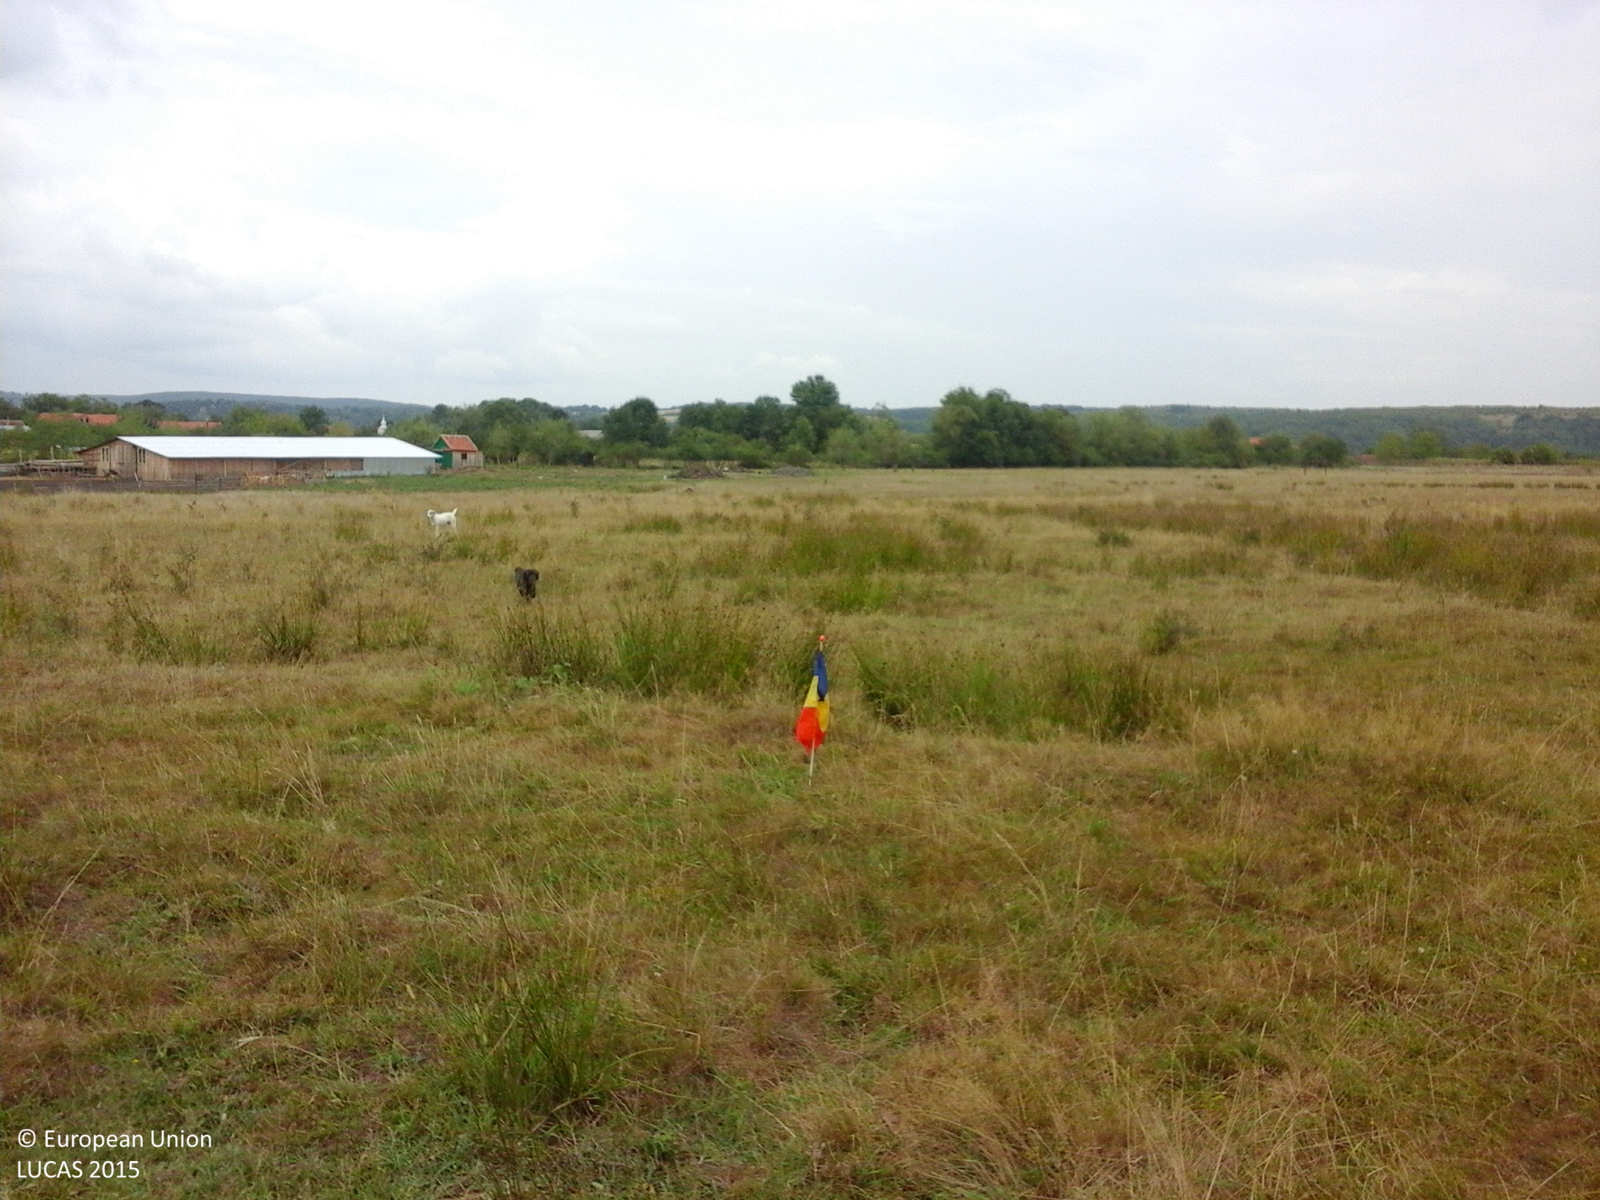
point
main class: Grassland
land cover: Grassland without tree/shrub cover
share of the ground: > 75 %
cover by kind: herbaceous plants 100 %
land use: Agriculture (excluding fallow land and kitchen gardens)
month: August
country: RO
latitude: 45.4865
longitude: 21.7163
